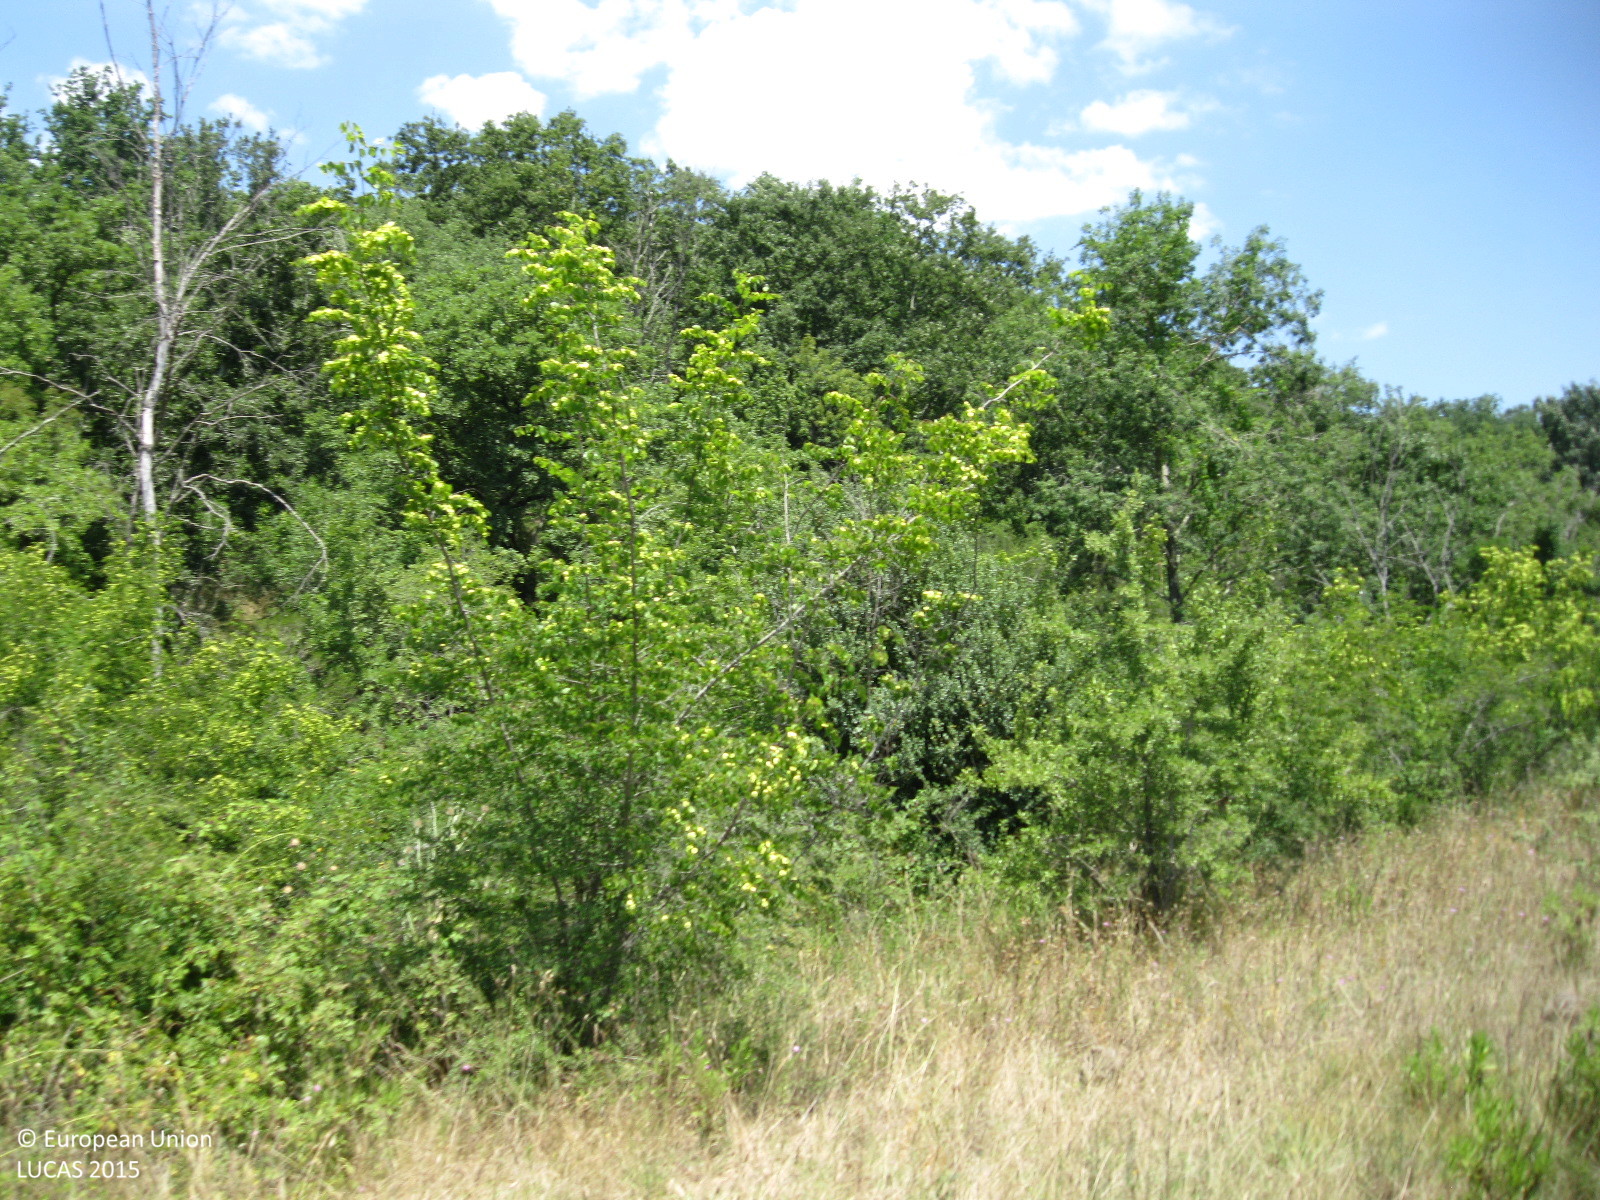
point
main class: Woodland
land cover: Broadleaved woodland
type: thermophilous deciduous forest
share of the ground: > 75 %
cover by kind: broadleaved forest trees 70 %, shrubs 25 %, herbaceous plants 5 %
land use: Forestry
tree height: > 5 m
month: July
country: IT
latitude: 42.6795
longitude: 11.4718
